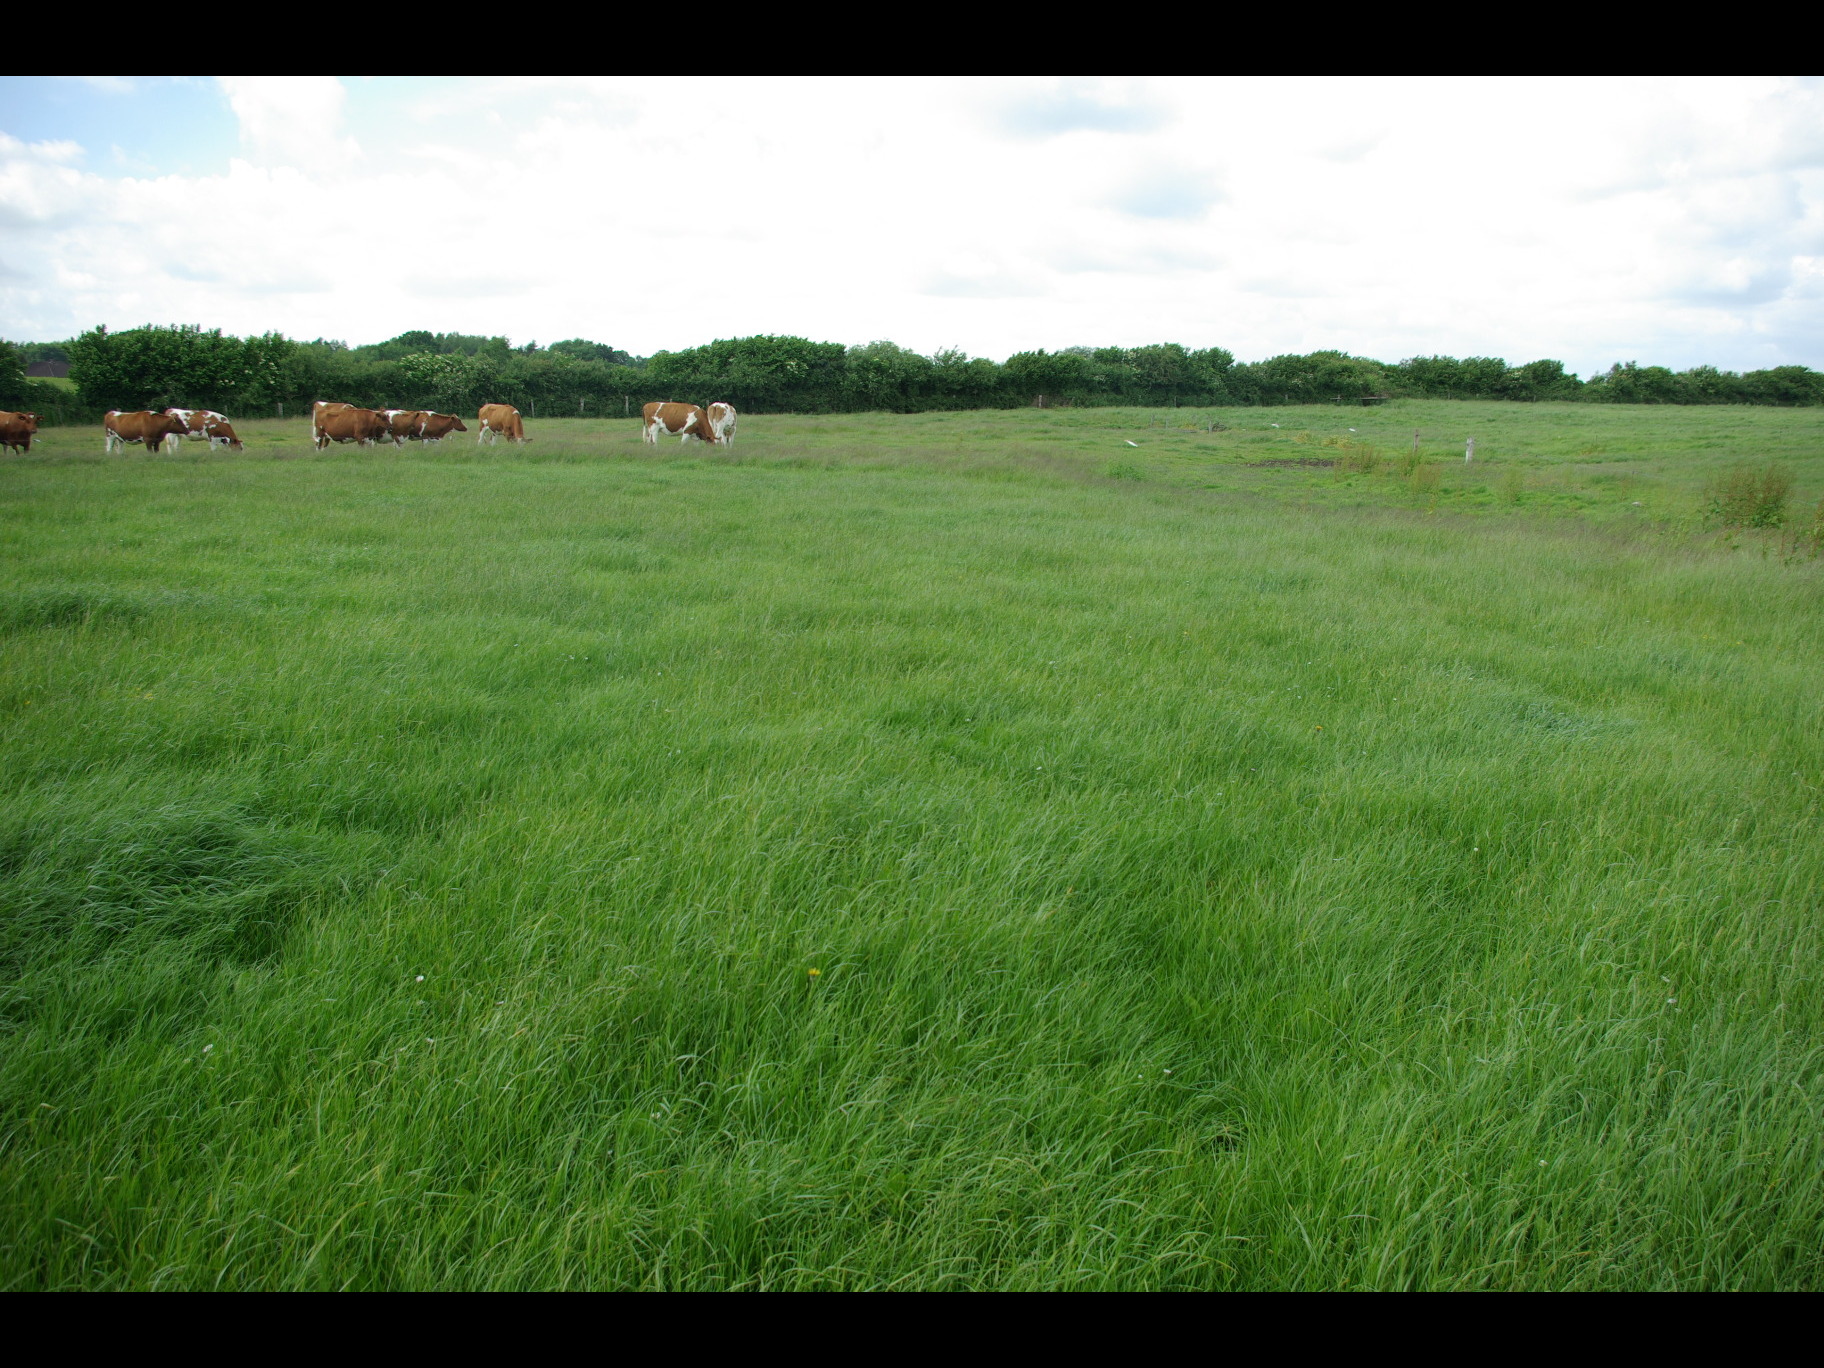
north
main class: Grassland
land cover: Grassland without tree/shrub cover
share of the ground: > 75 %
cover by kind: herbaceous plants 100 %
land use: Agriculture (excluding fallow land and kitchen gardens)
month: June
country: DE
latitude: 54.2107
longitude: 9.9540
